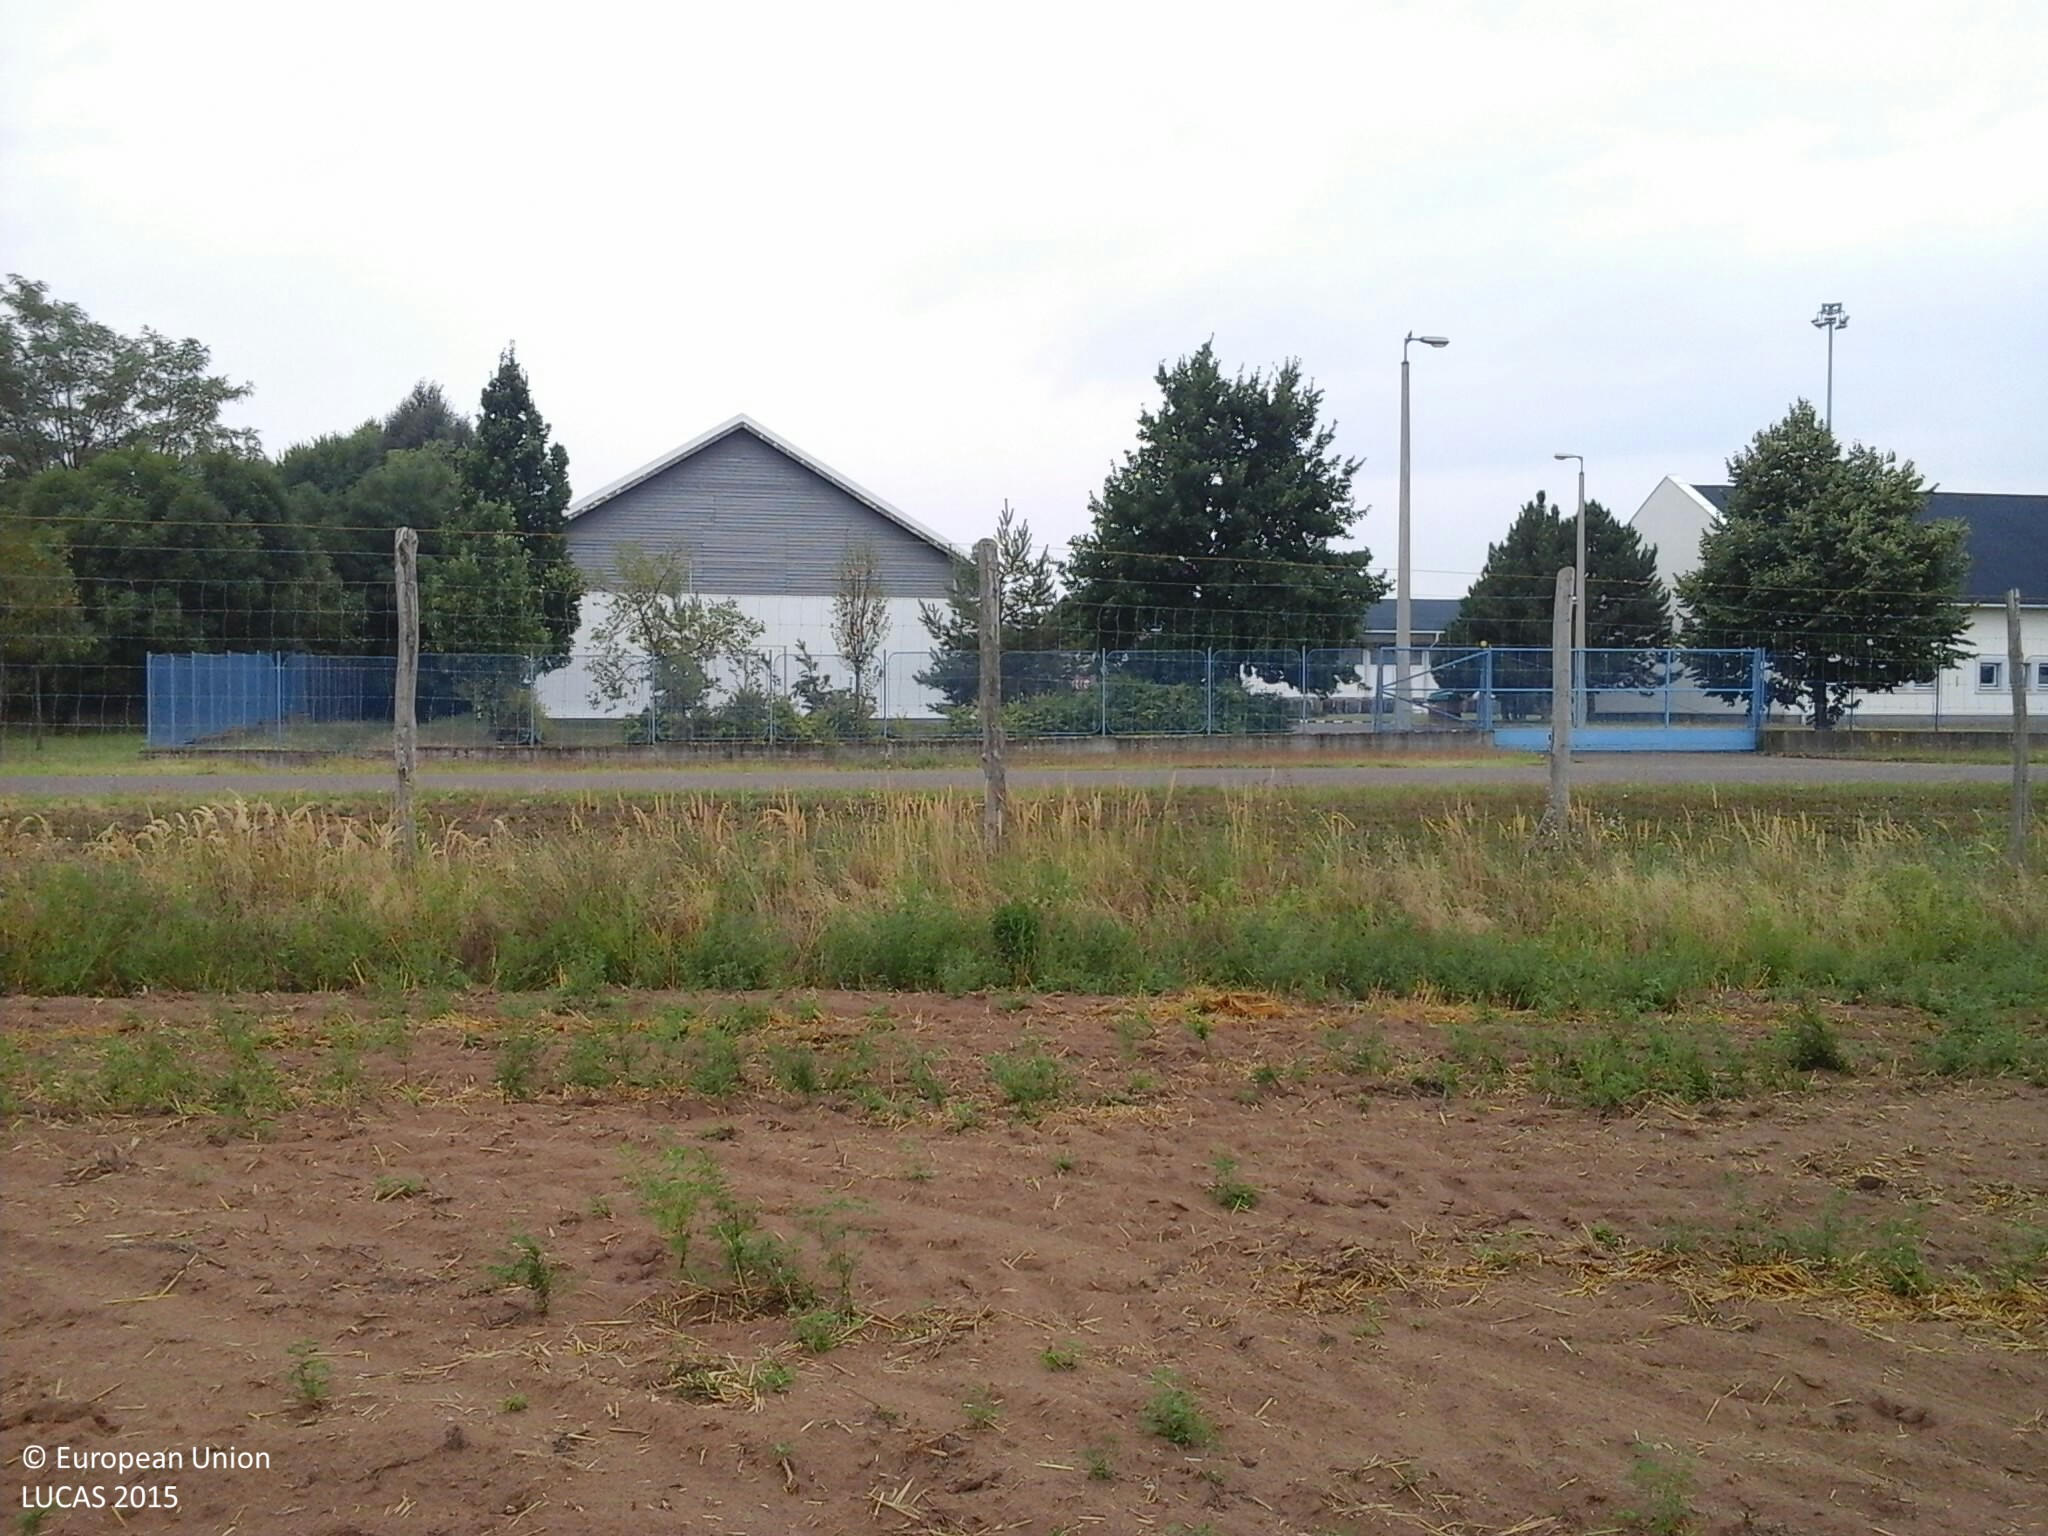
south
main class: Cropland
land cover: Common wheat
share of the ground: 10 - 25 %
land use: Agriculture (excluding fallow land and kitchen gardens)
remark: Harvested field
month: August
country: HU
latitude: 47.7234
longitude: 20.2818
